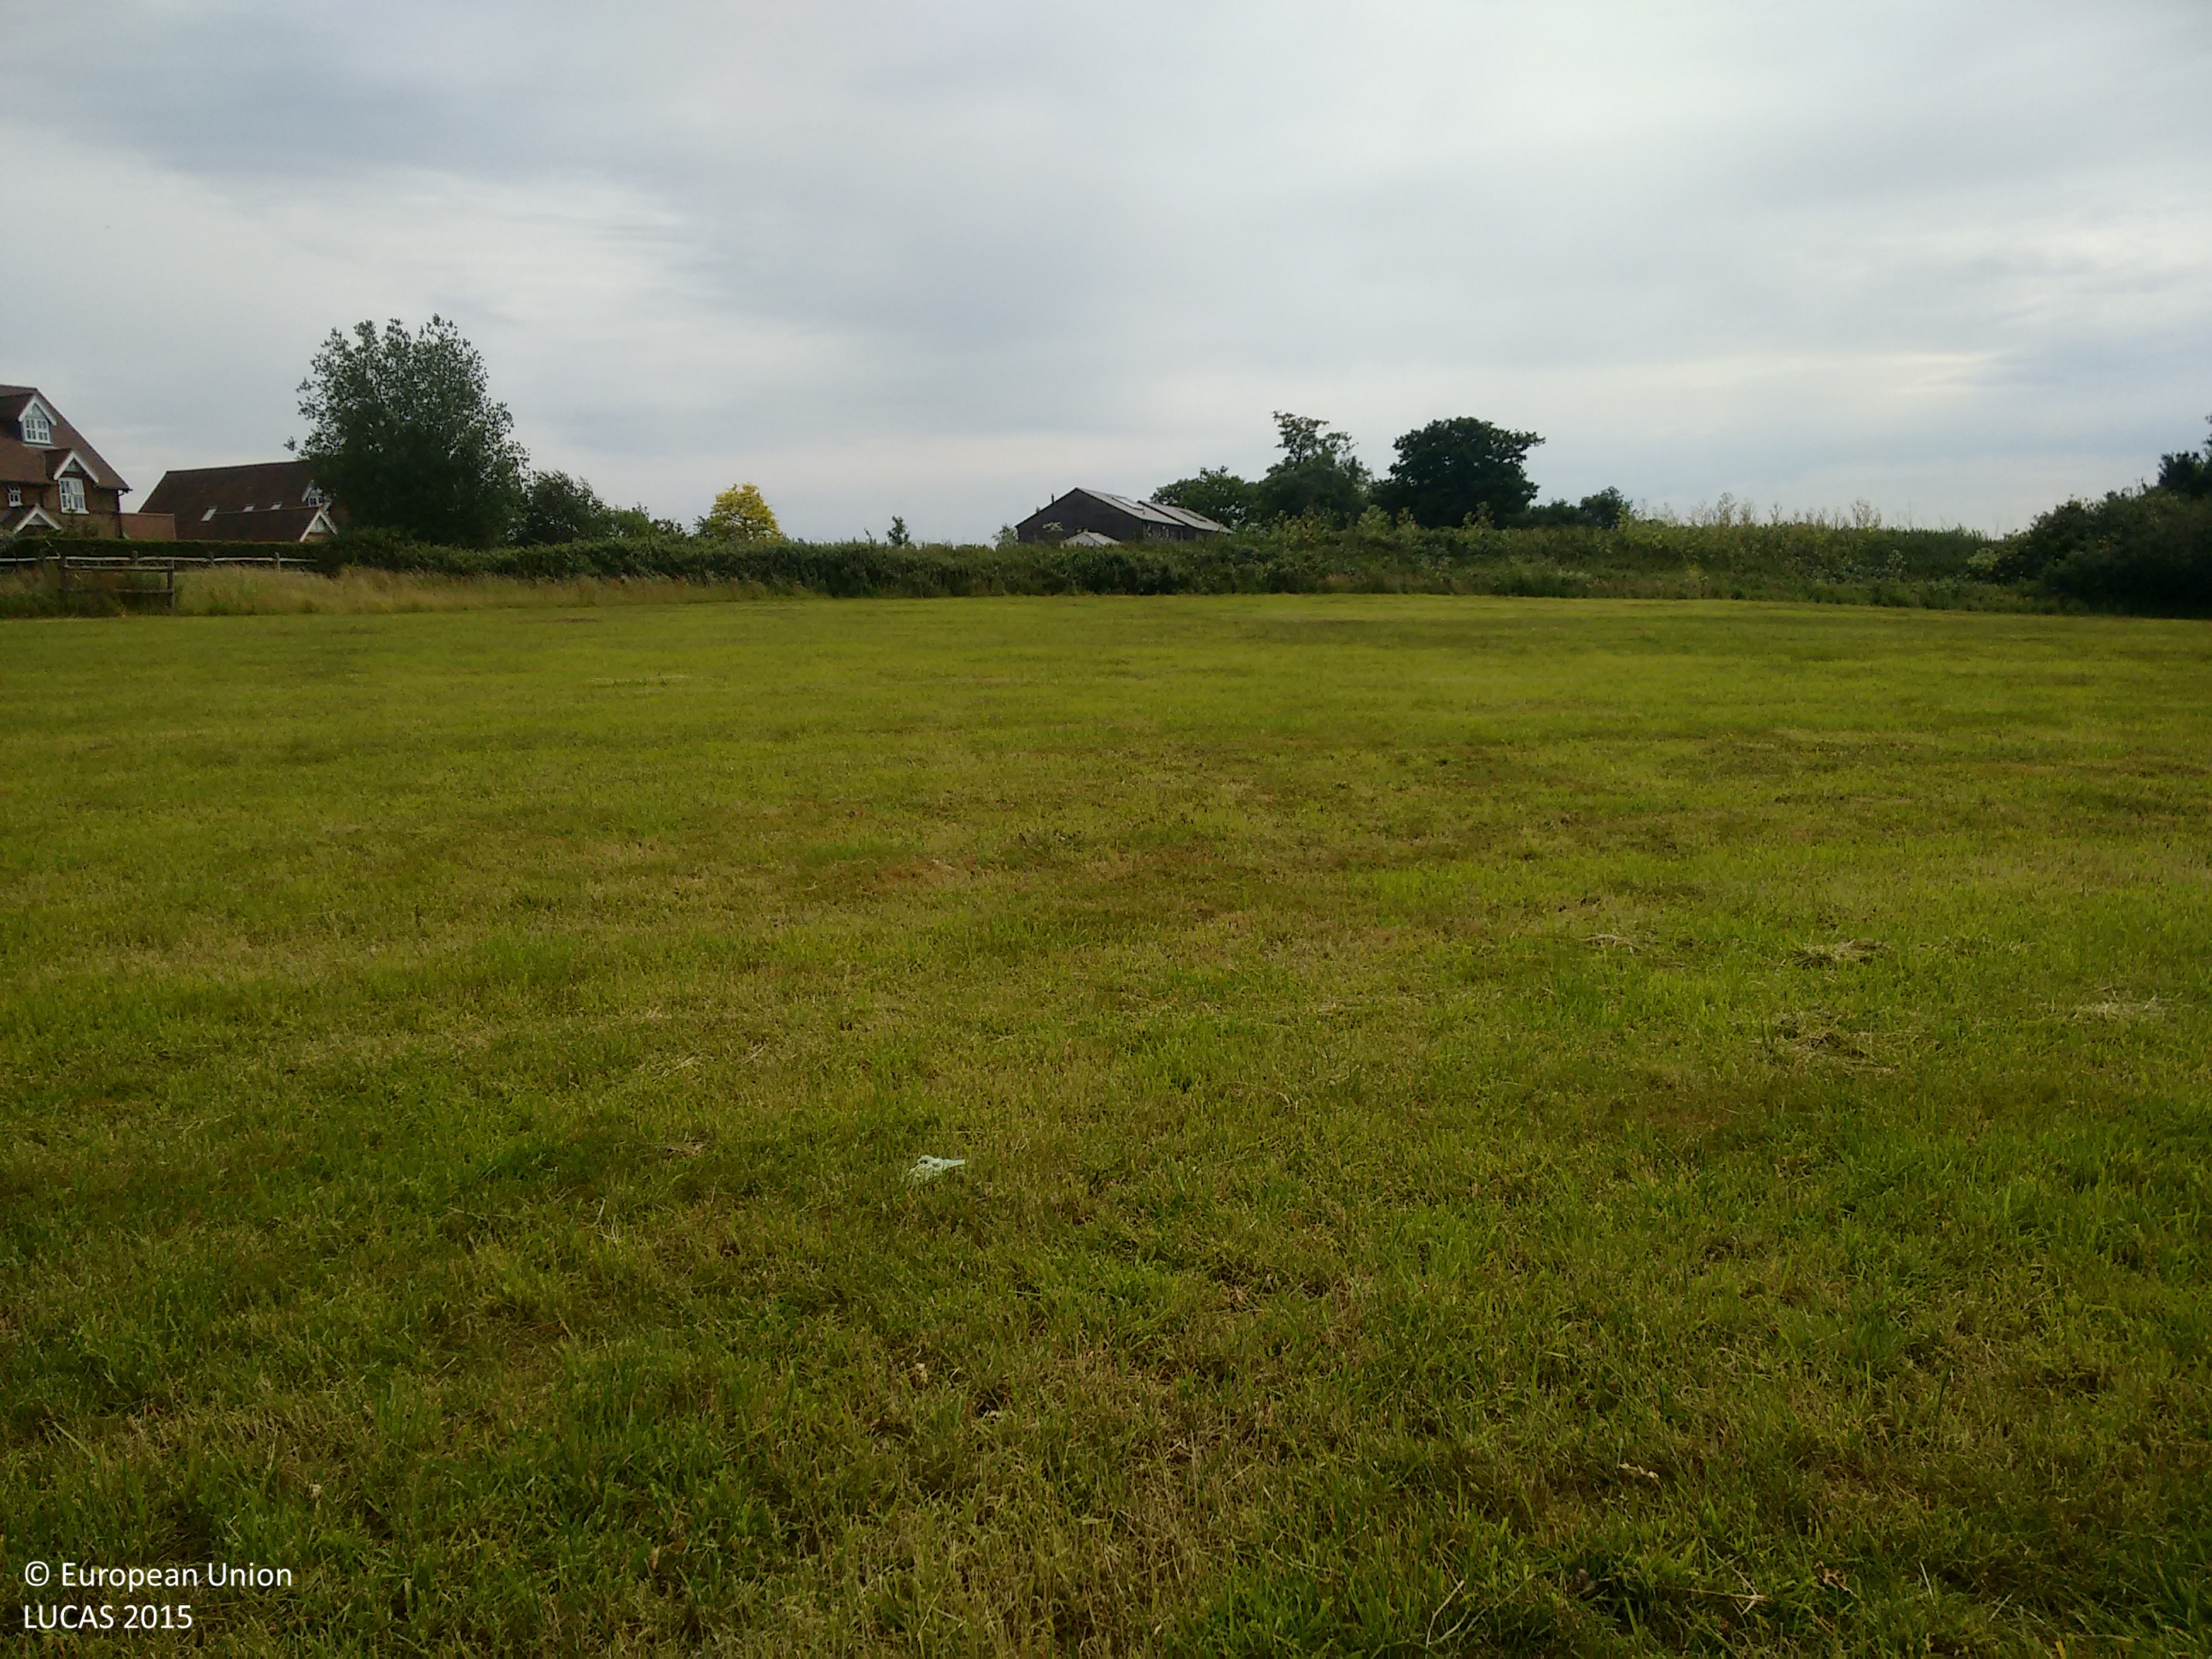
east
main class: Grassland
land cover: Grassland without tree/shrub cover
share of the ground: > 75 %
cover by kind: herbaceous plants 100 %
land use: Agriculture (excluding fallow land and kitchen gardens)
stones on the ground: < 10 %
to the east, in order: Grassland without tree/shrub cover; Shrubland without tree cover; Grassland without tree/shrub cover; Artificial constructions in urban areas; Grass margins; Maize
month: June
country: GB
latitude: 51.2208
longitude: -0.0994
